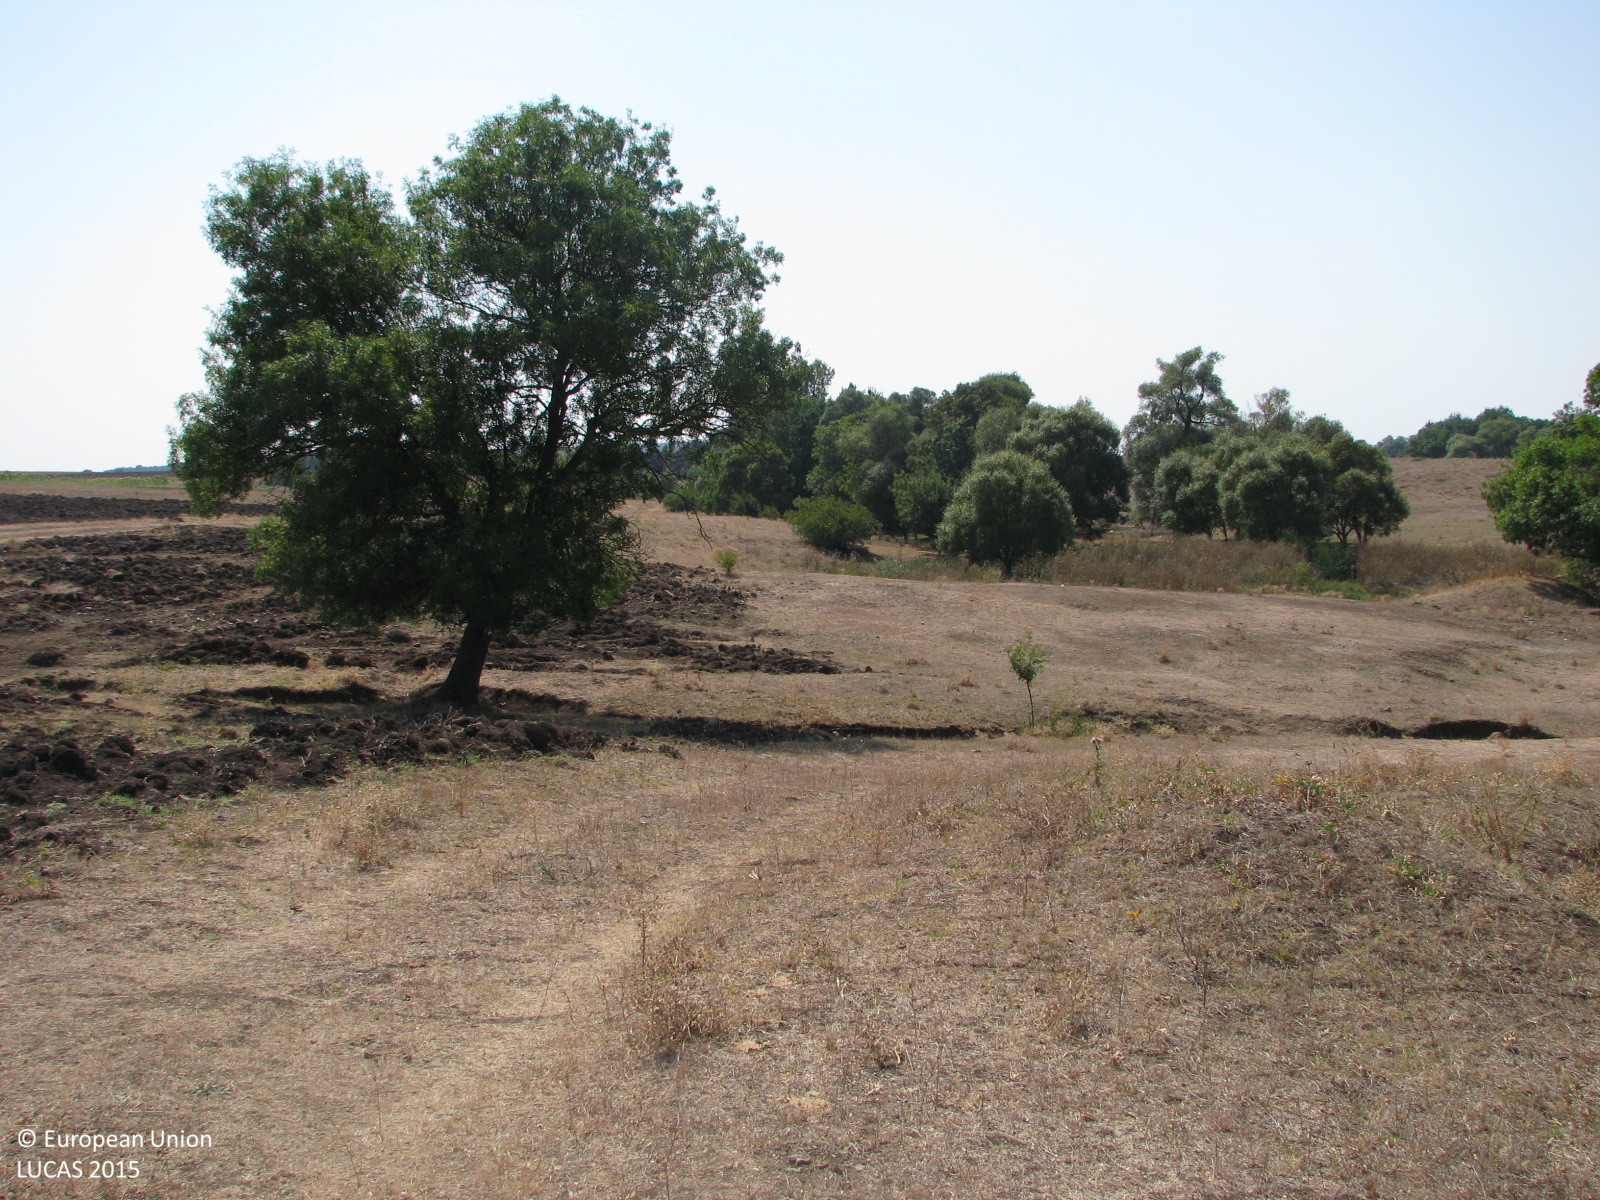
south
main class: Grassland
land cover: Grassland without tree/shrub cover
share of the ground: > 75 %
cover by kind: herbaceous plants 90 %, unconsolidated bare surface 10 %
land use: Agriculture (excluding fallow land and kitchen gardens)
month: September
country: BG
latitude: 42.3805
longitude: 26.7979
